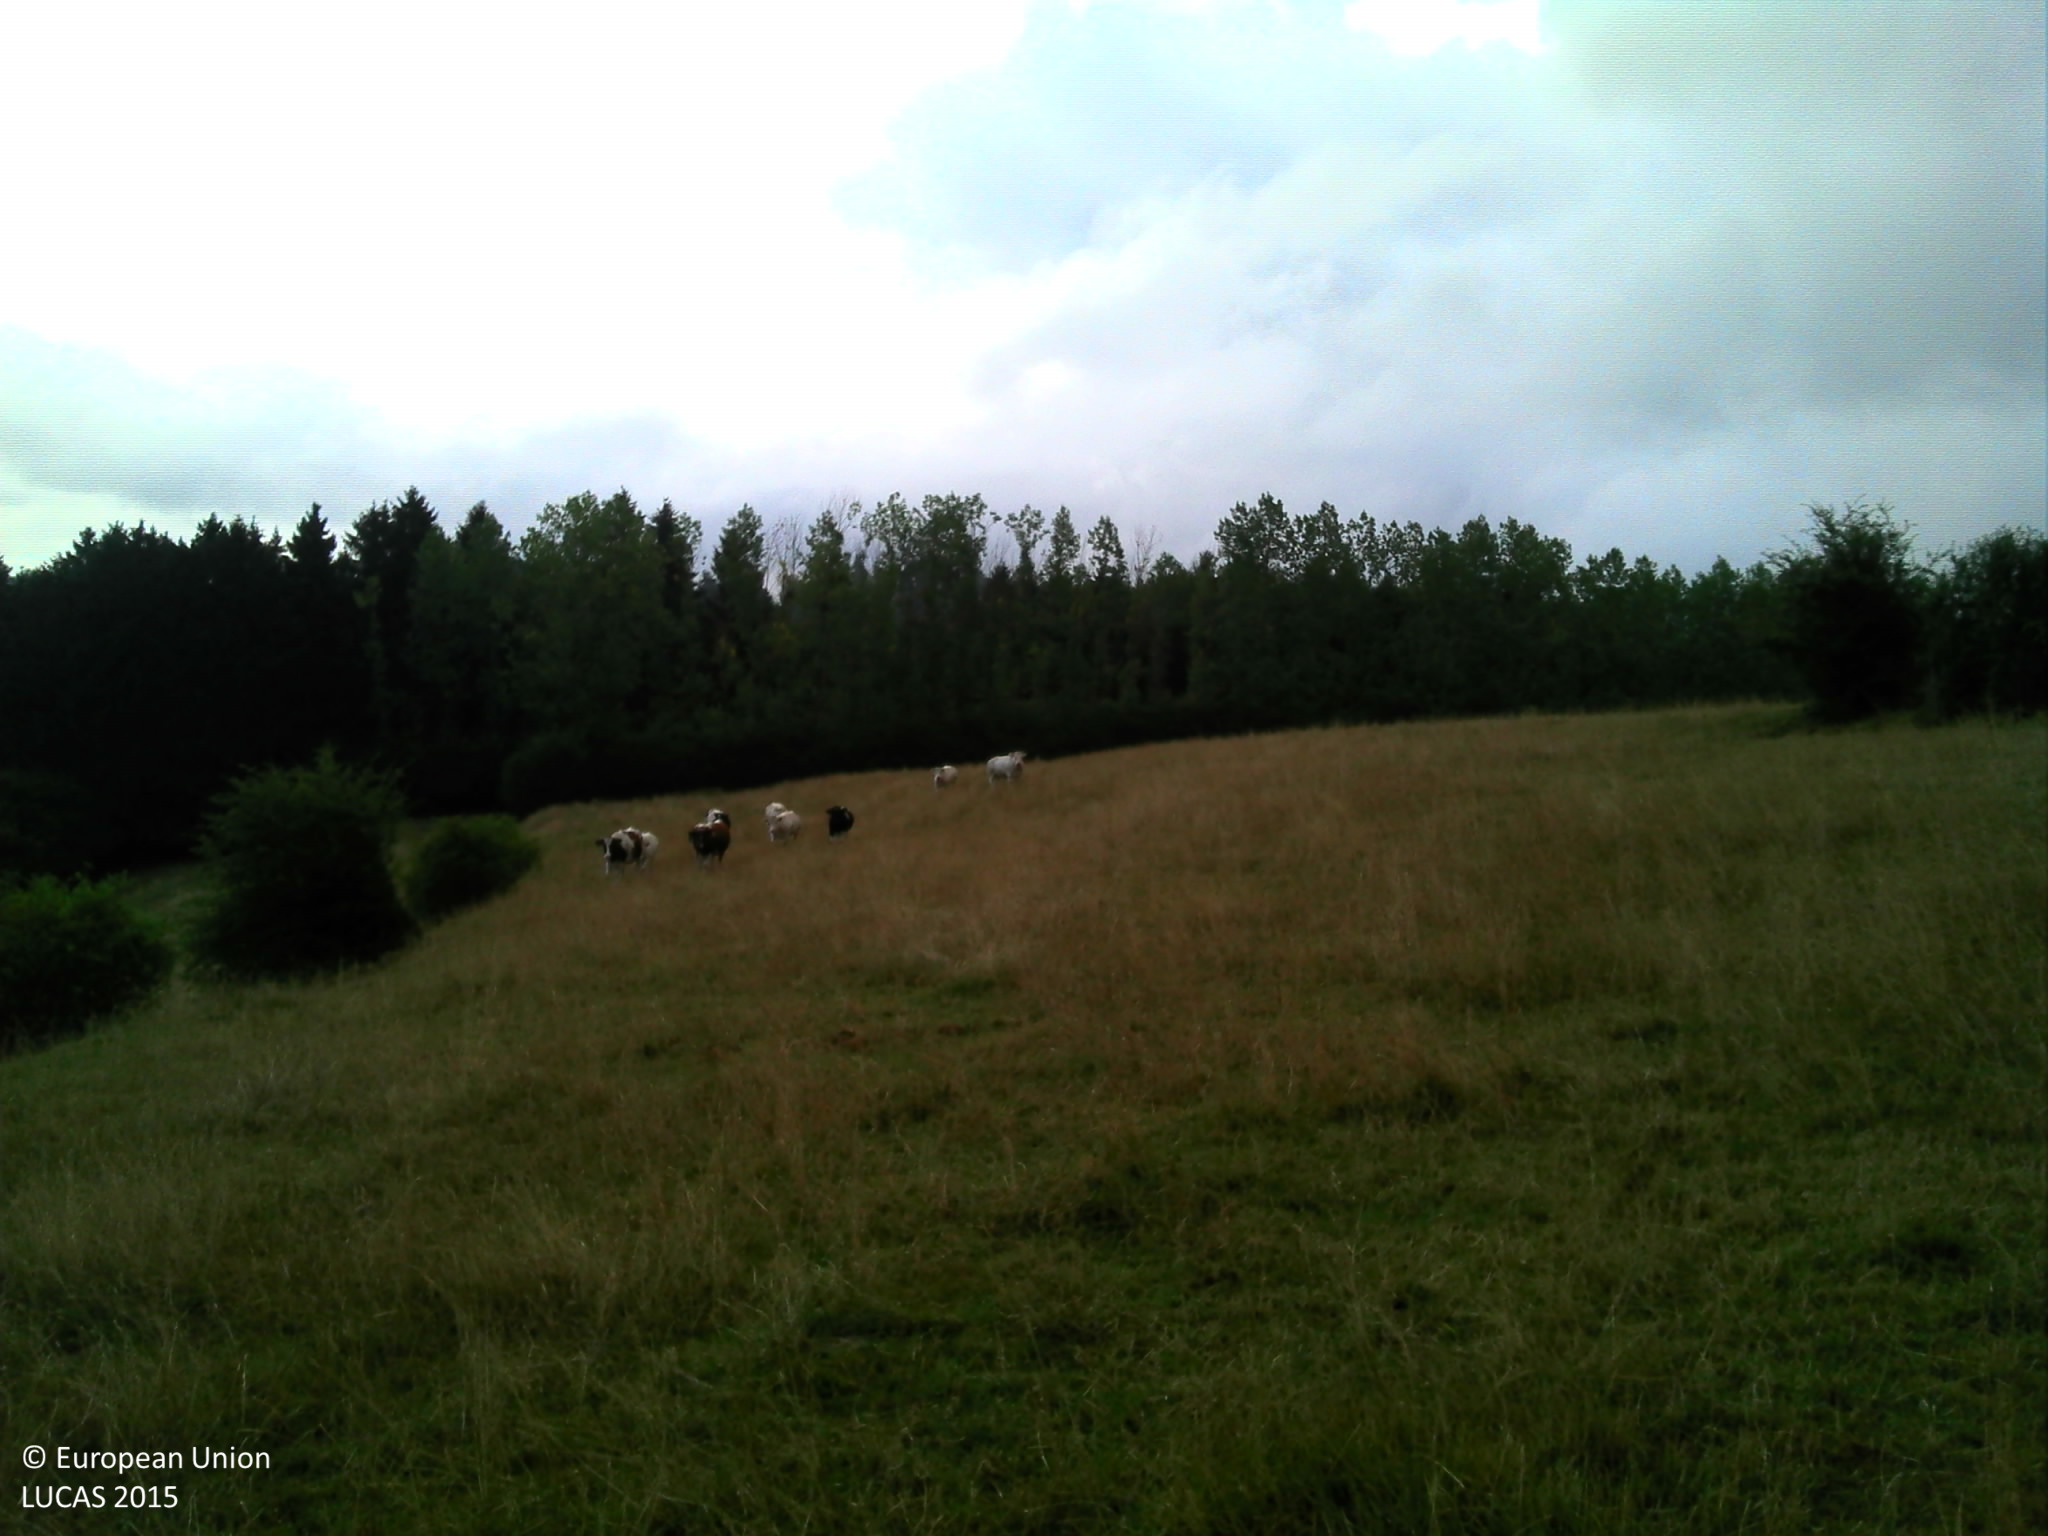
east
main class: Grassland
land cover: Grassland without tree/shrub cover
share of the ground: > 75 %
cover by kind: herbaceous plants 100 %
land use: Agriculture (excluding fallow land and kitchen gardens)
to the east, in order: Grassland without tree/shrub cover; Fences; Abandoned hedges; Broadleaved woodland; Spruce dominated mixed woodland; Broadleaved woodland
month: July
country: BE
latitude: 49.6019
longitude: 5.7787
